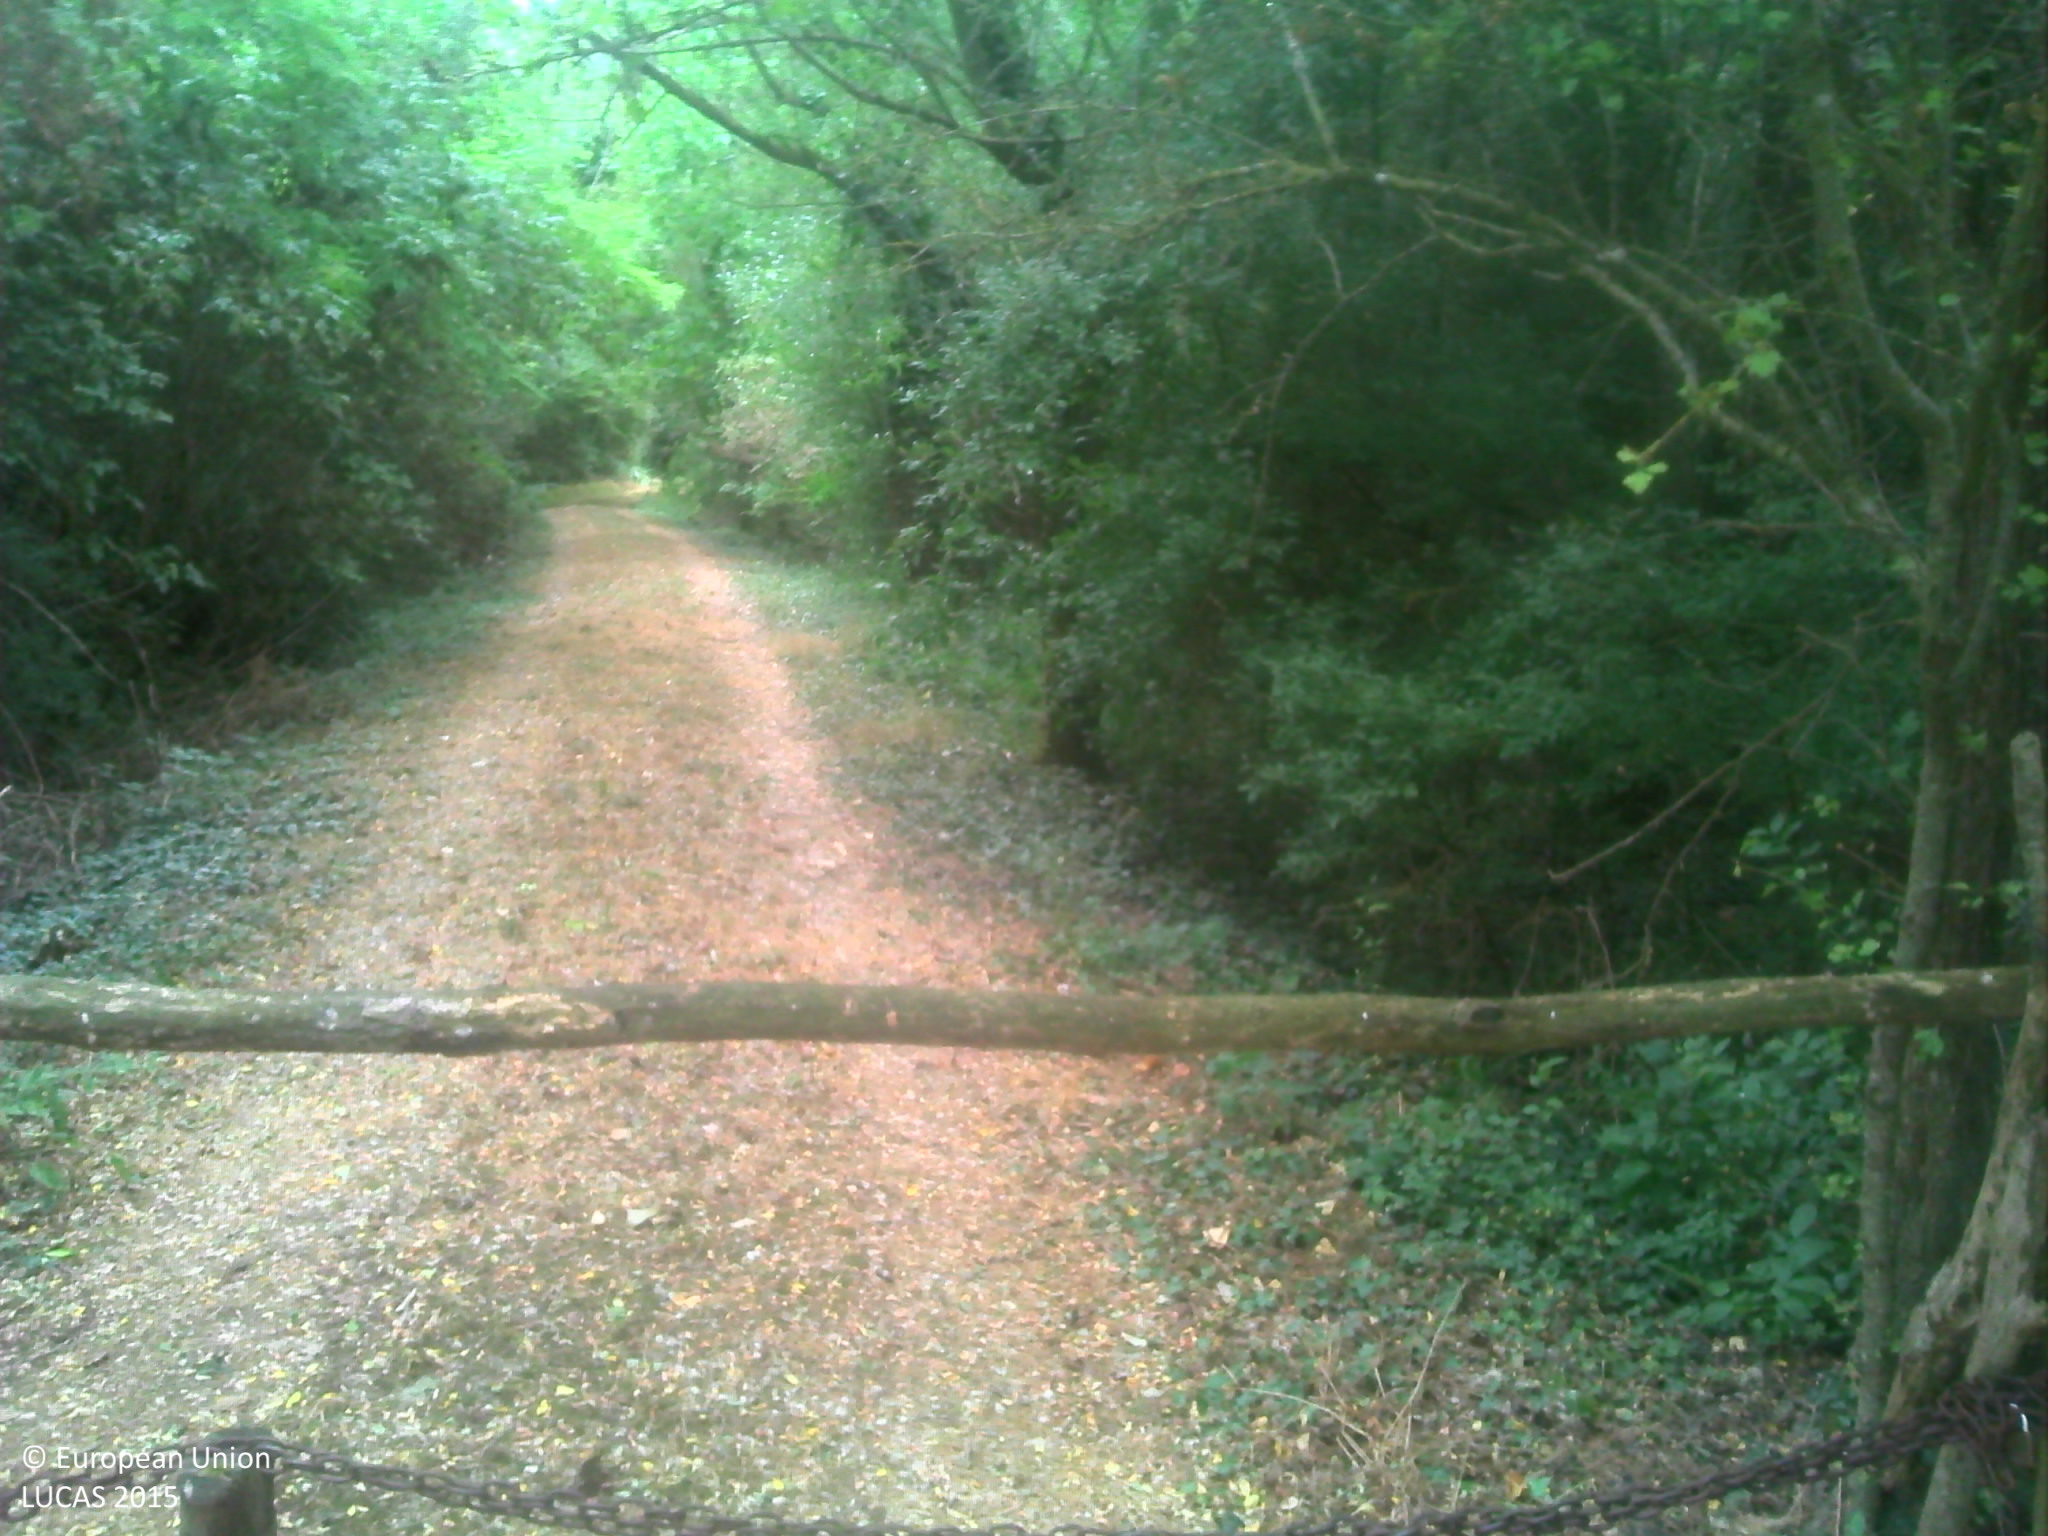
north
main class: Woodland
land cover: Broadleaved woodland
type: mesophytic deciduous forest
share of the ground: > 75 %
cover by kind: broadleaved forest trees 50 %, herbaceous plants 50 %
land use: Semi-natural and natural areas not in use
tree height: > 5 m
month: July
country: FR
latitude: 47.7167
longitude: 1.3062
